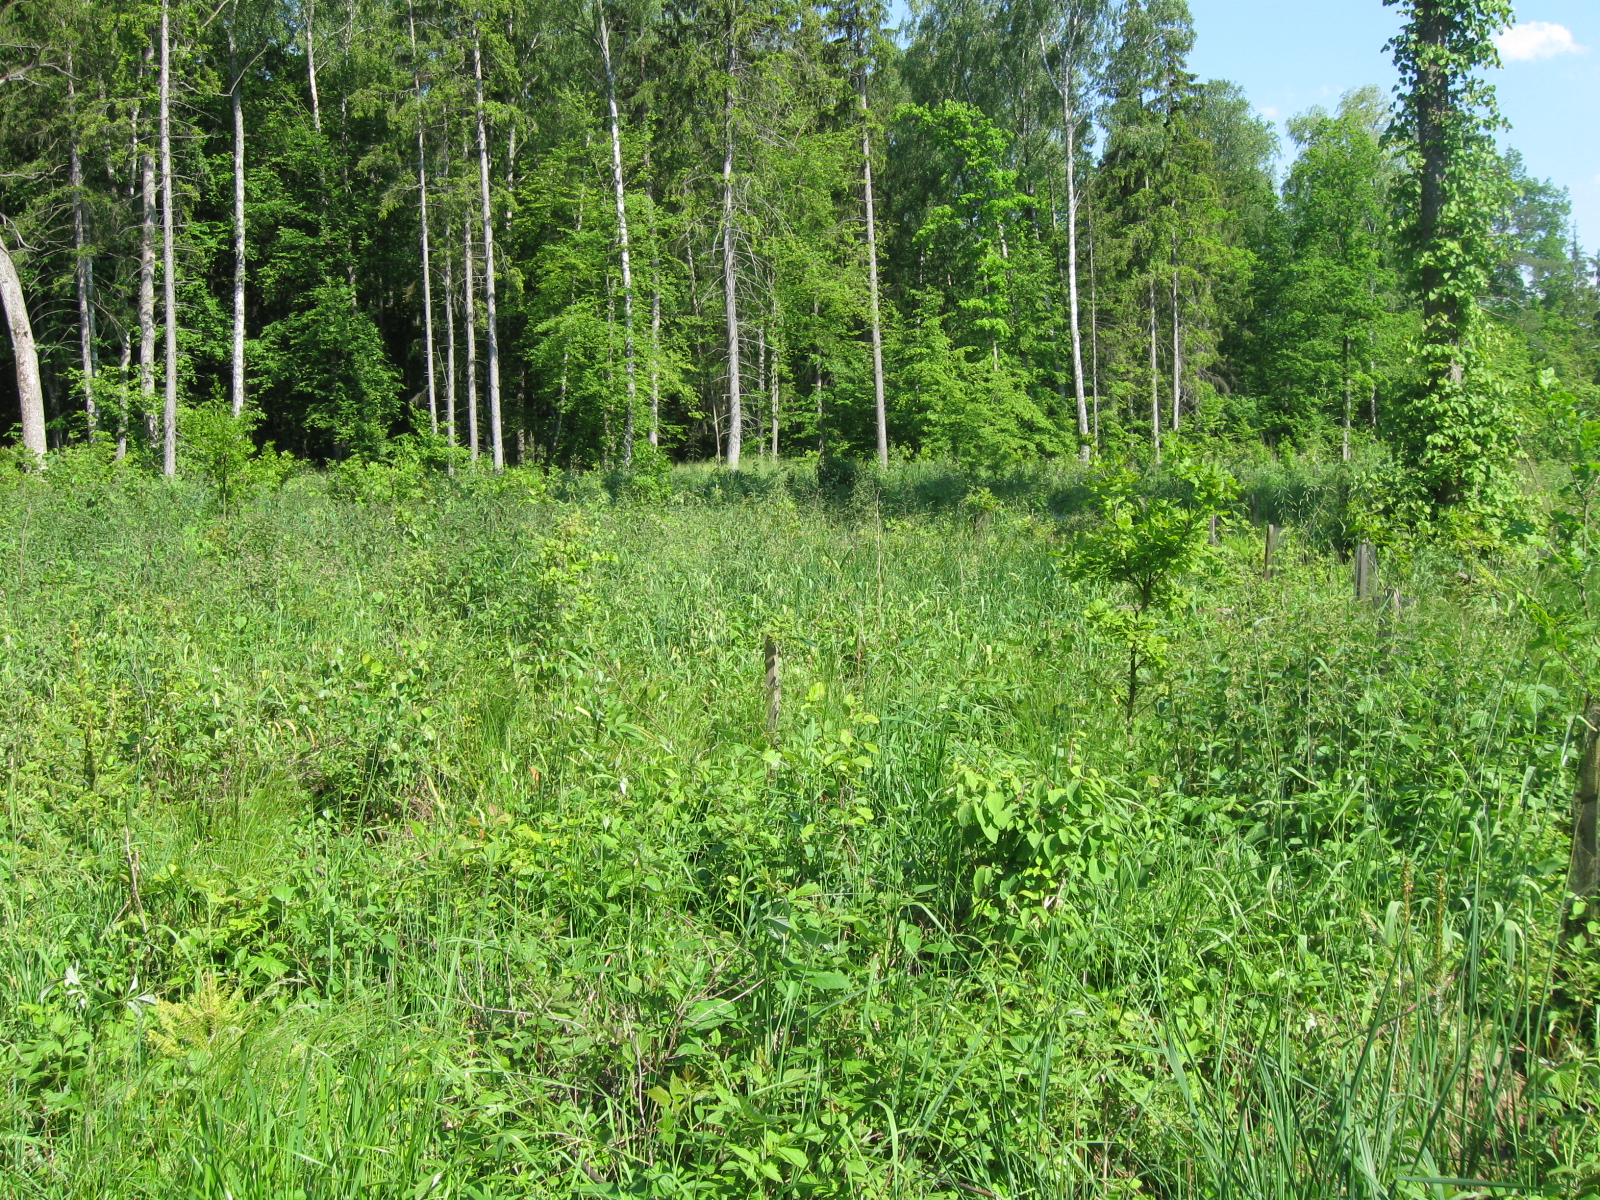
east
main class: Woodland
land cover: Broadleaved woodland
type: non-riverine alder, birch or aspen forest
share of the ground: 10 - 25 %
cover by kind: herbaceous plants 70 %, broadleaved forest trees 15 %, shrubs 10 %, coniferous forest trees 5 %
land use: Forestry
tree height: < 5 m
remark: Nursery
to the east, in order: Broadleaved woodland; Other mixed woodland; Tracks; Other mixed woodland; Spruce dominated mixed woodland
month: June
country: LT
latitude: 54.2682
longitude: 23.8000
